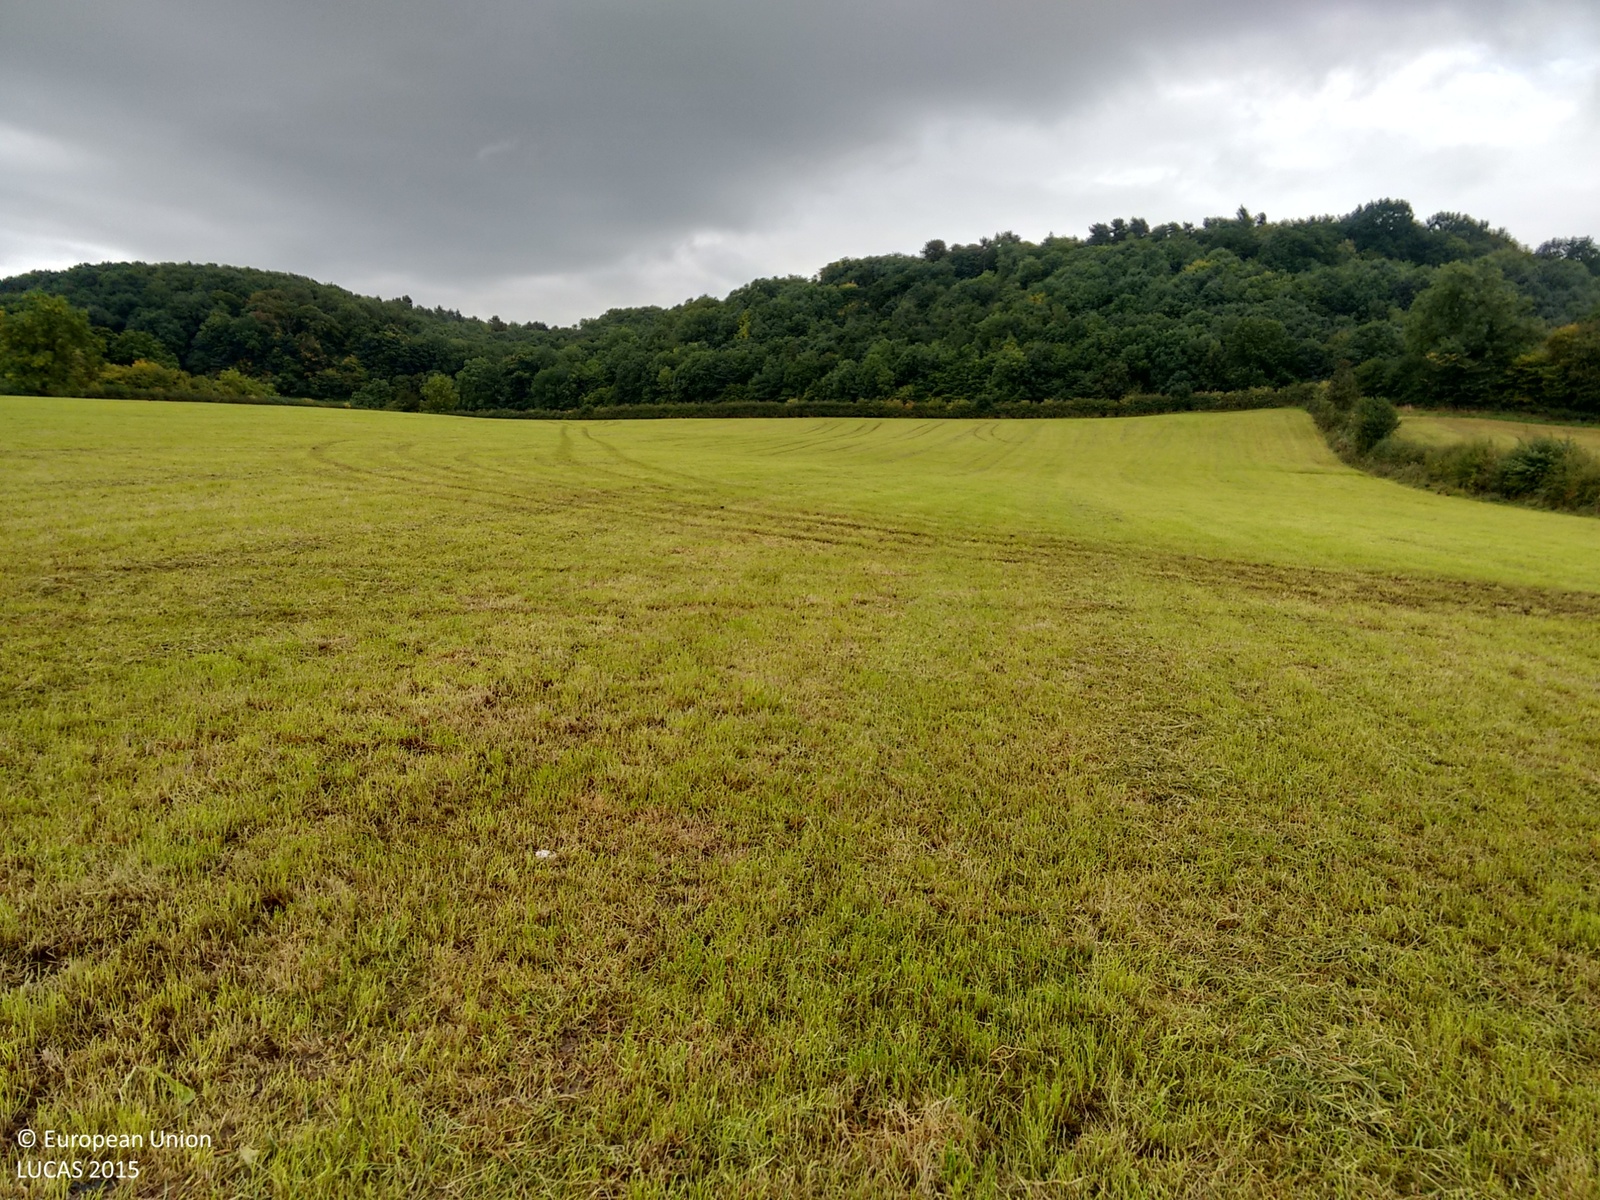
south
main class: Grassland
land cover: Grassland without tree/shrub cover
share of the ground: > 75 %
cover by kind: herbaceous plants 100 %
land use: Agriculture (excluding fallow land and kitchen gardens)
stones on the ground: < 10 %
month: September
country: GB
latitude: 52.8557
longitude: -1.8324
